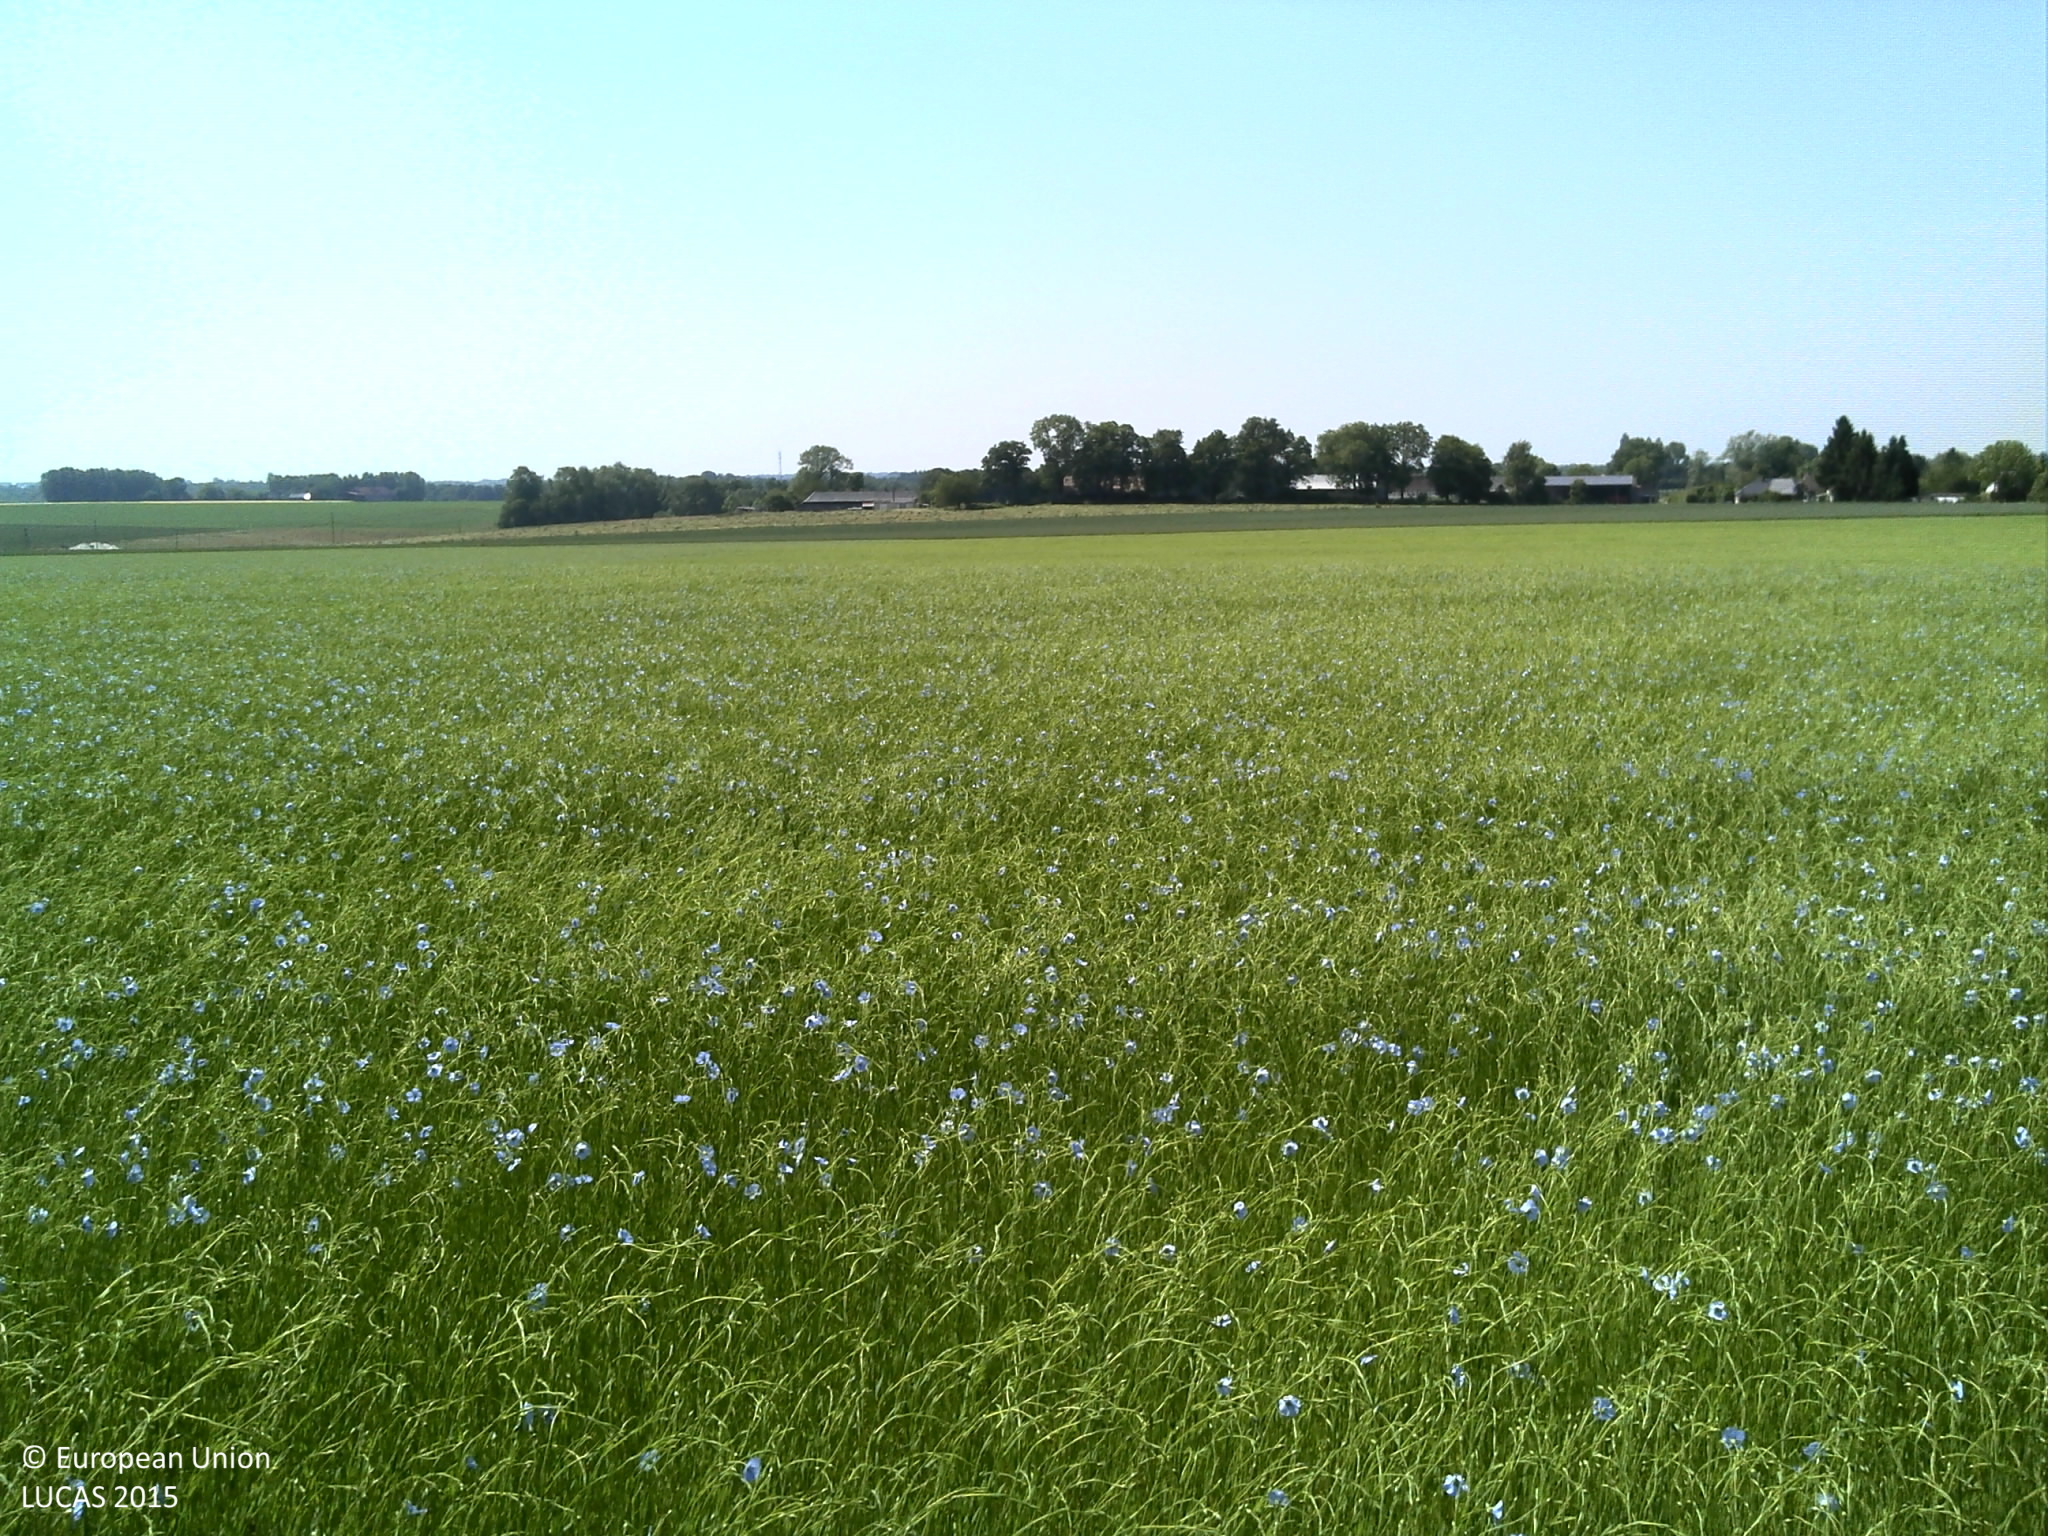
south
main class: Cropland
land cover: Other fibre and oleaginous crops
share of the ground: > 75 %
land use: Agriculture (excluding fallow land and kitchen gardens)
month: June
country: FR
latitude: 49.5876
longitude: 1.1675
